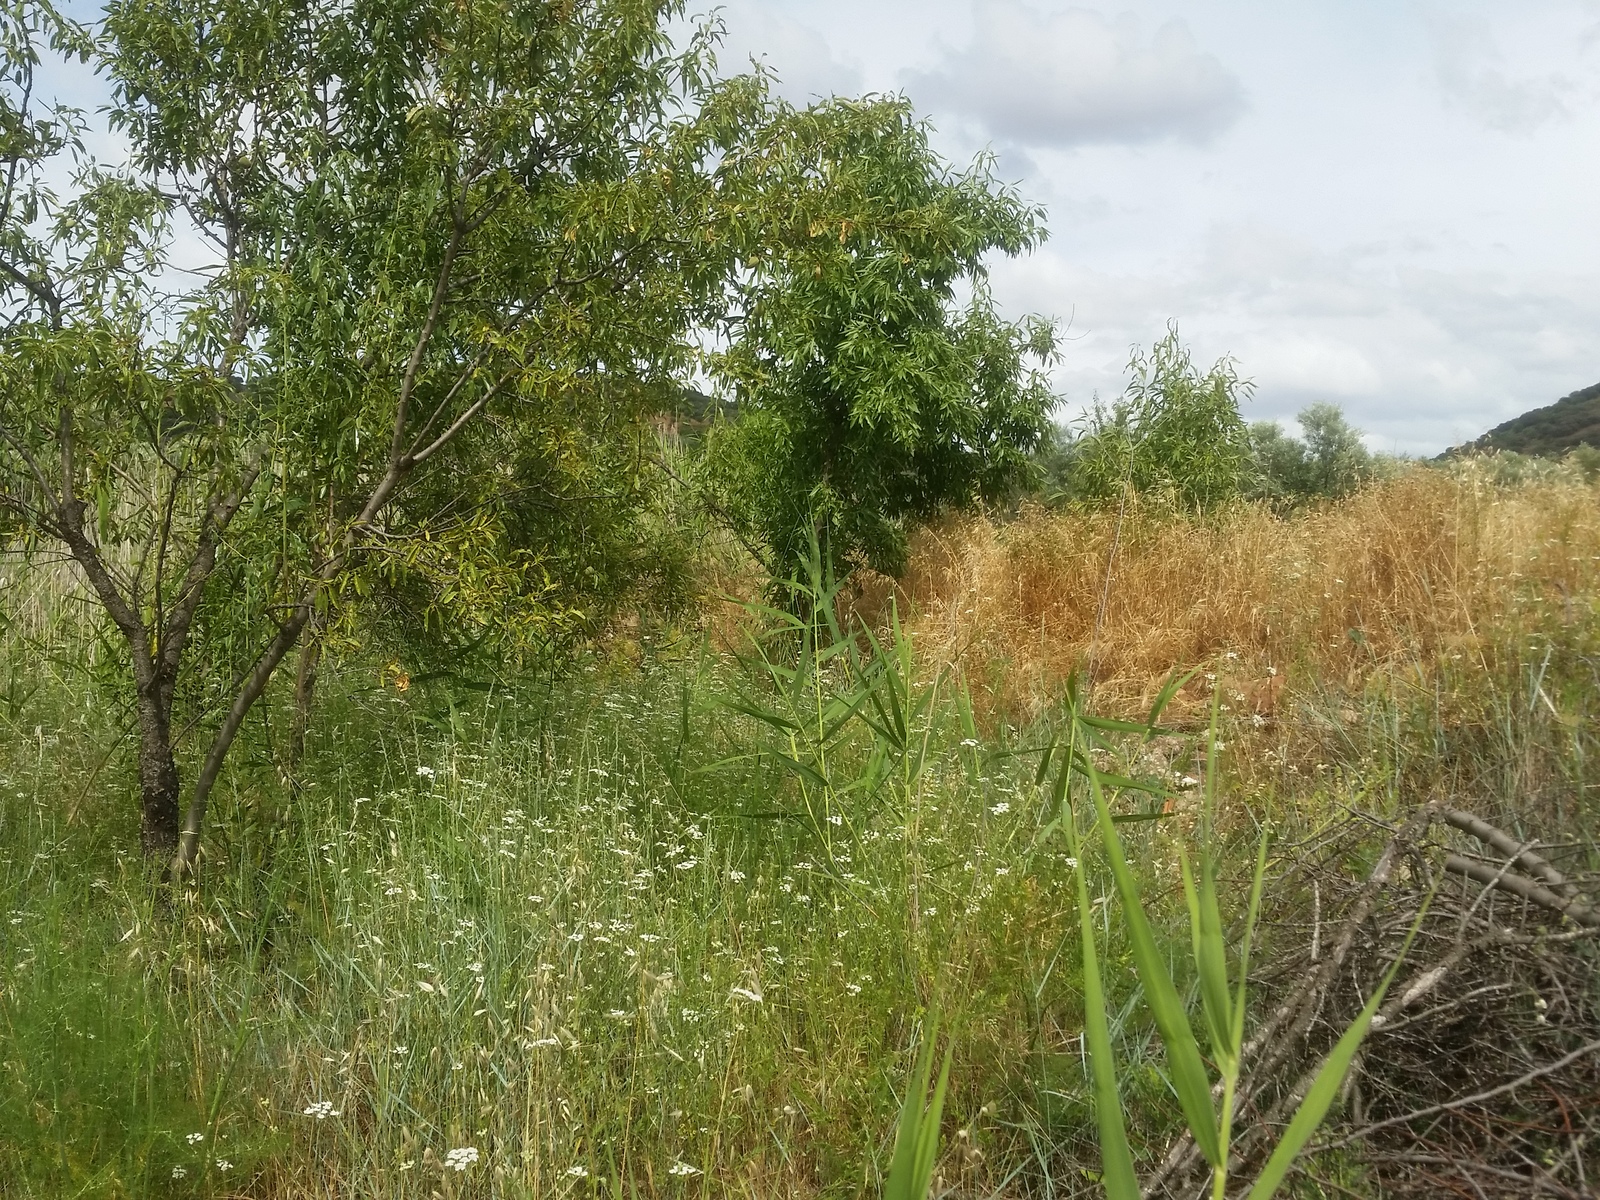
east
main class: Cropland
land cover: Nuts trees
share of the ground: 50 - 75 %
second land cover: Grassland without tree/shrub cover
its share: > 75 %
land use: Abandoned areas
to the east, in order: Nuts trees; Grassland without tree/shrub cover; Tracks; Grass margins; Oats; Olive groves
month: June
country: ES
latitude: 38.7021
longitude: -2.5935
